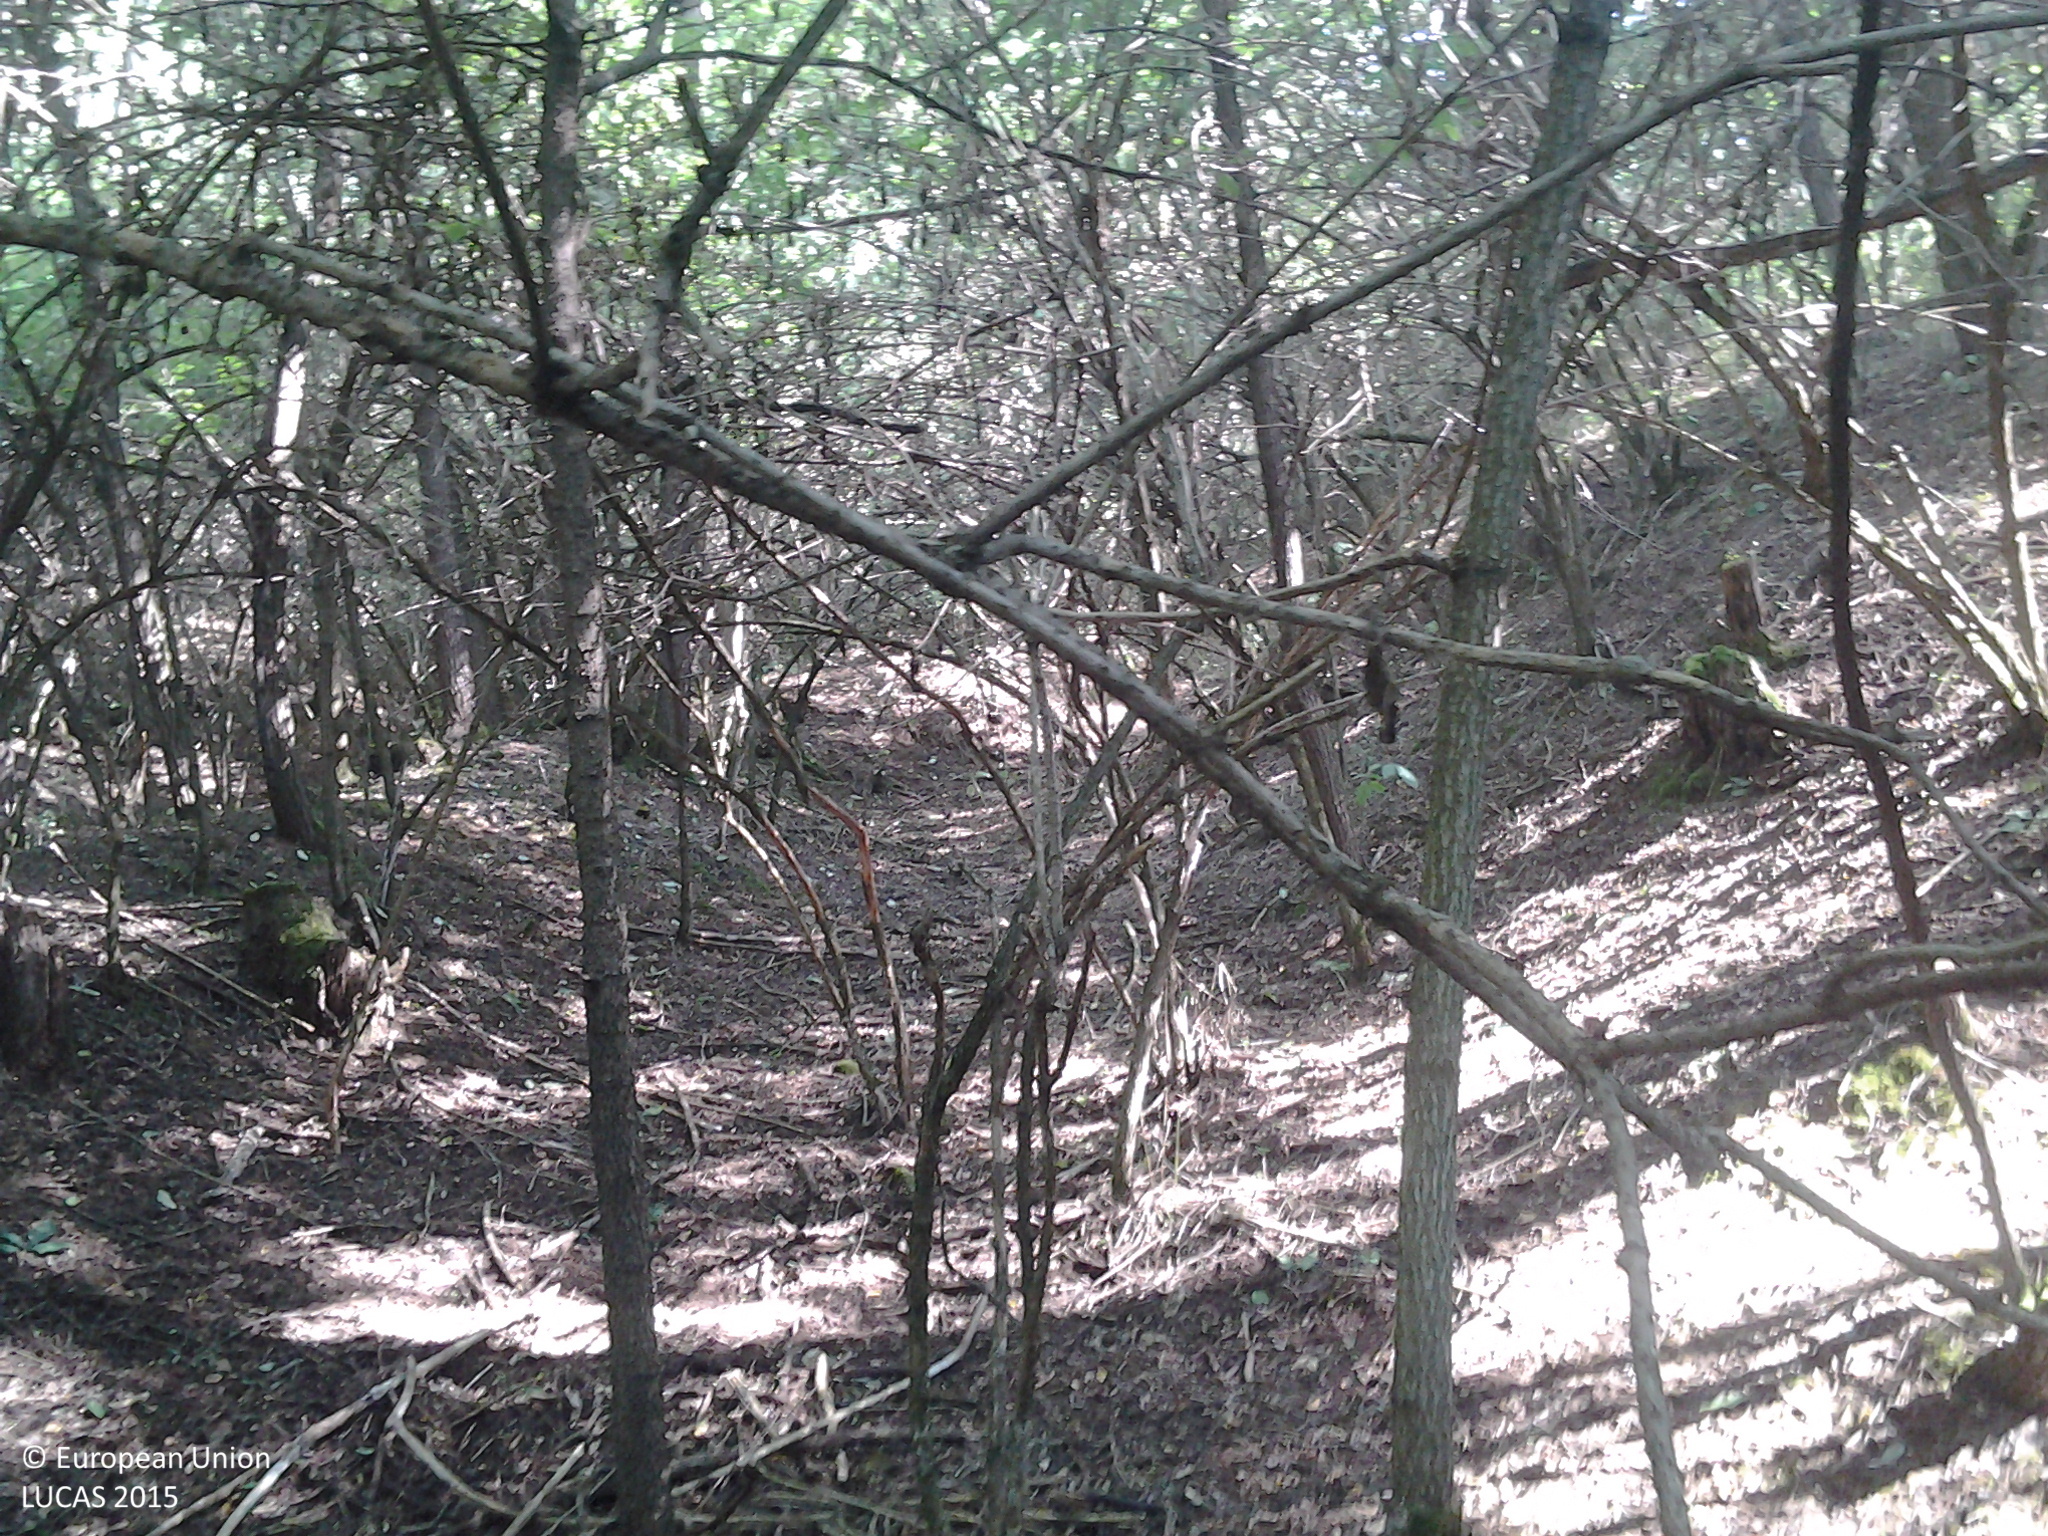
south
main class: Woodland
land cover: Broadleaved woodland
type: mesophytic deciduous forest
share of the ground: > 75 %
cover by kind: broadleaved forest trees 80 %, shrubs 20 %
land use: Forestry
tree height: > 5 m
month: August
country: HU
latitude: 48.0095
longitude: 19.9337
